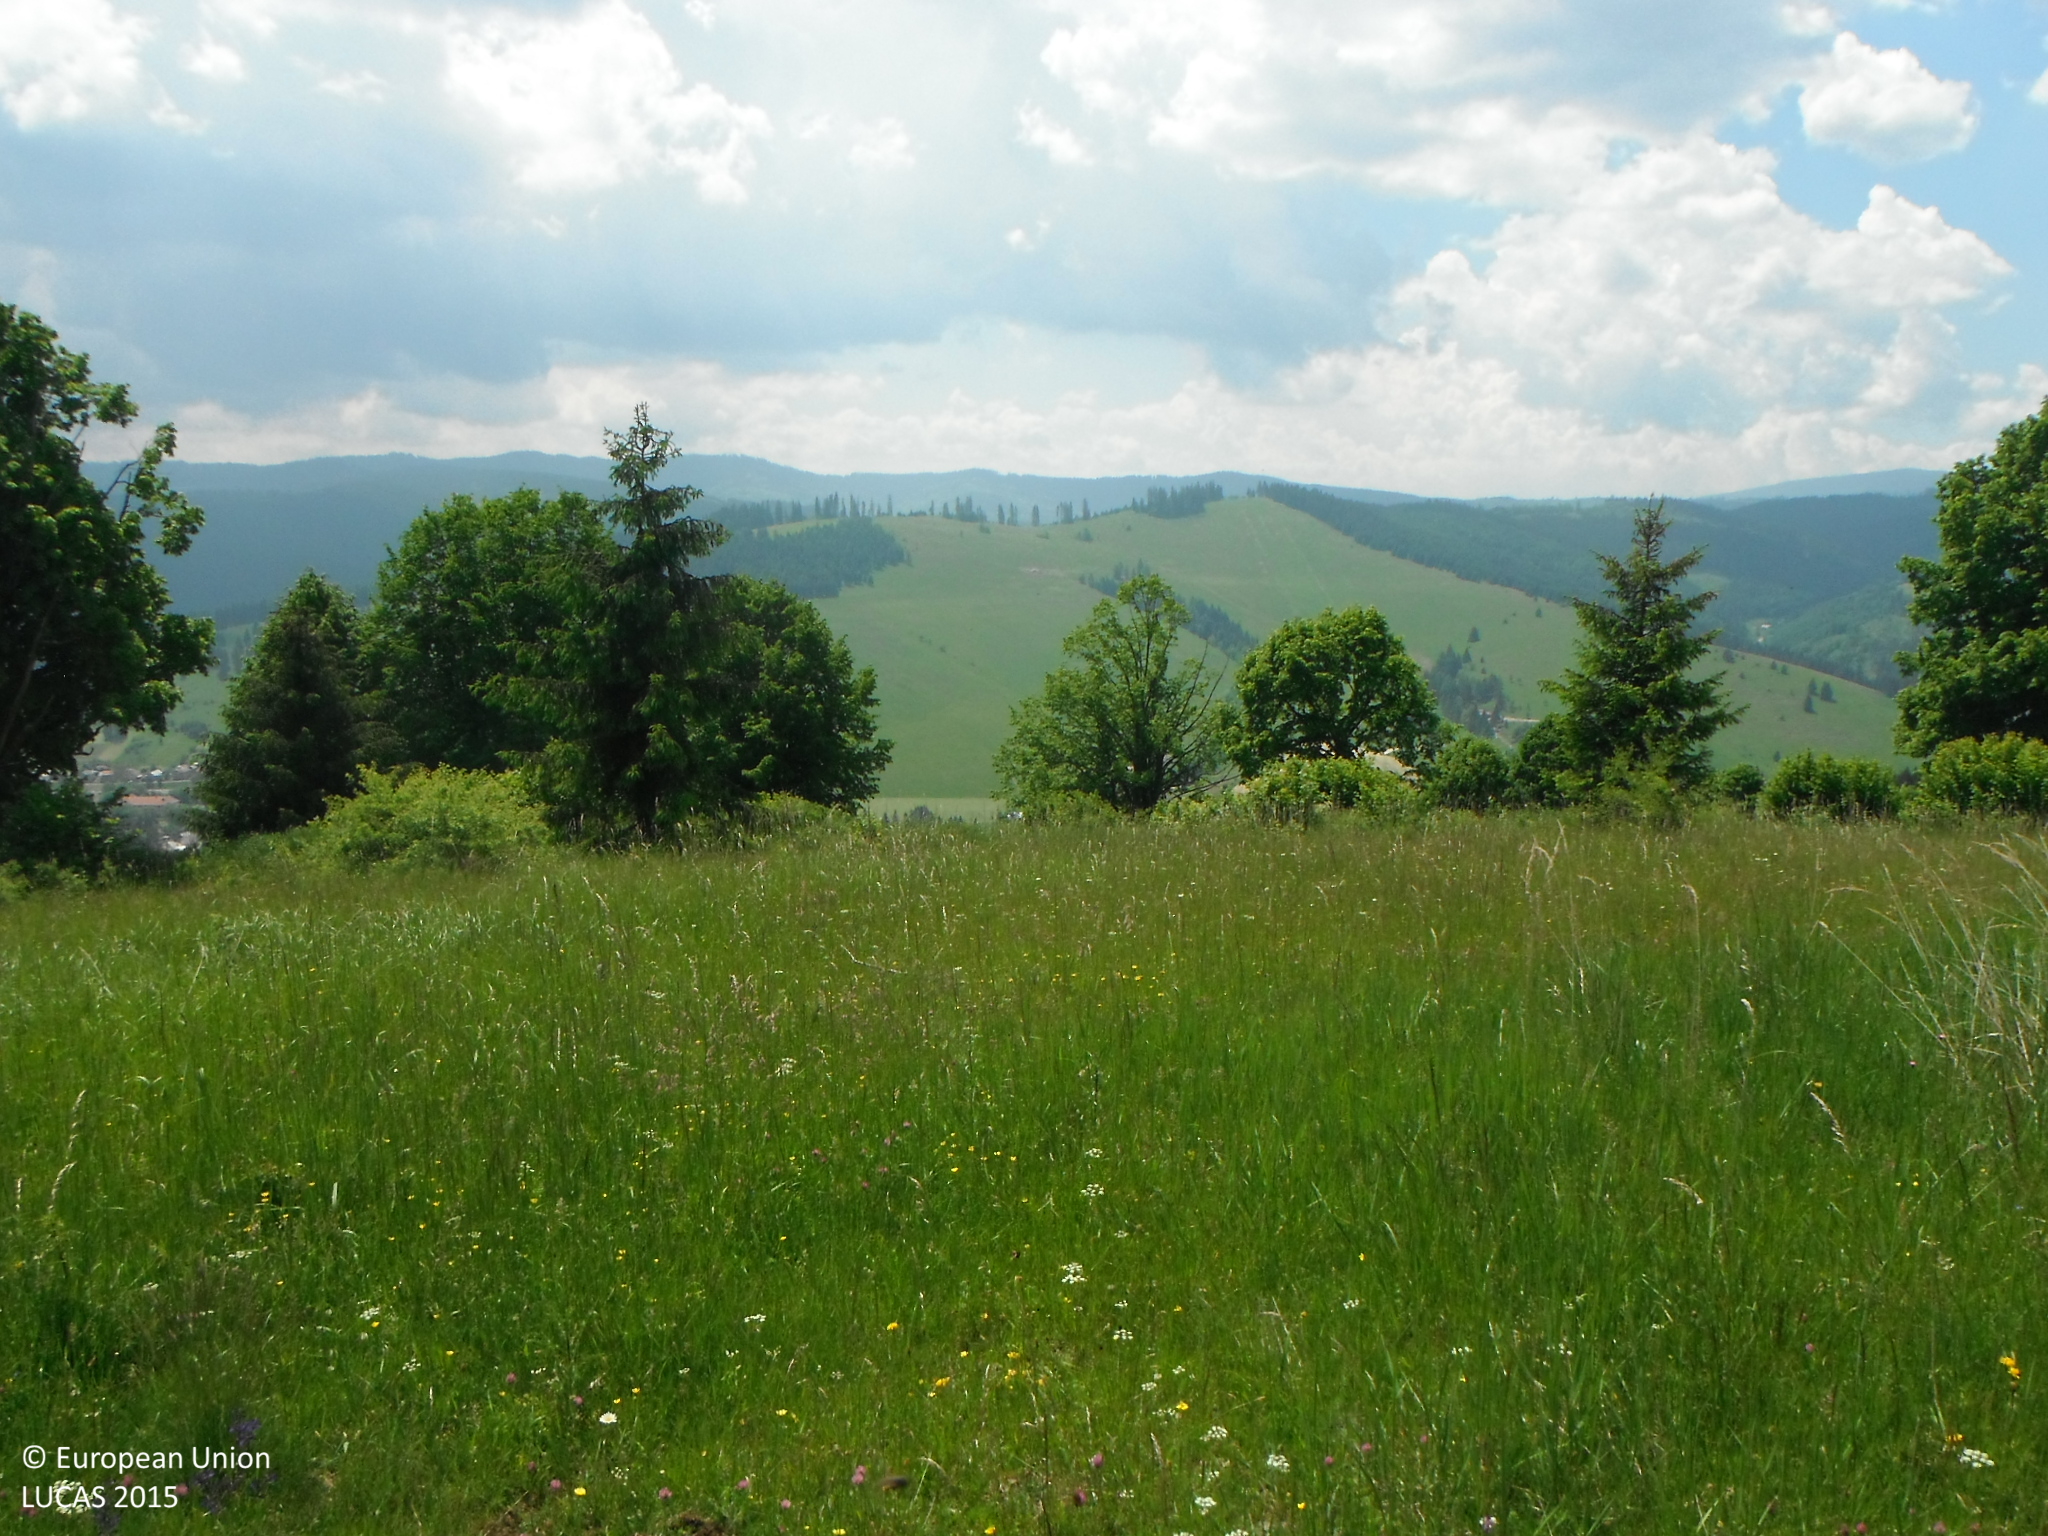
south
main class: Grassland
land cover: Grassland without tree/shrub cover
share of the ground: > 75 %
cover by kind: herbaceous plants 100 %
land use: Agriculture (excluding fallow land and kitchen gardens)
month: June
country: SK
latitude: 48.7601
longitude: 19.6444
